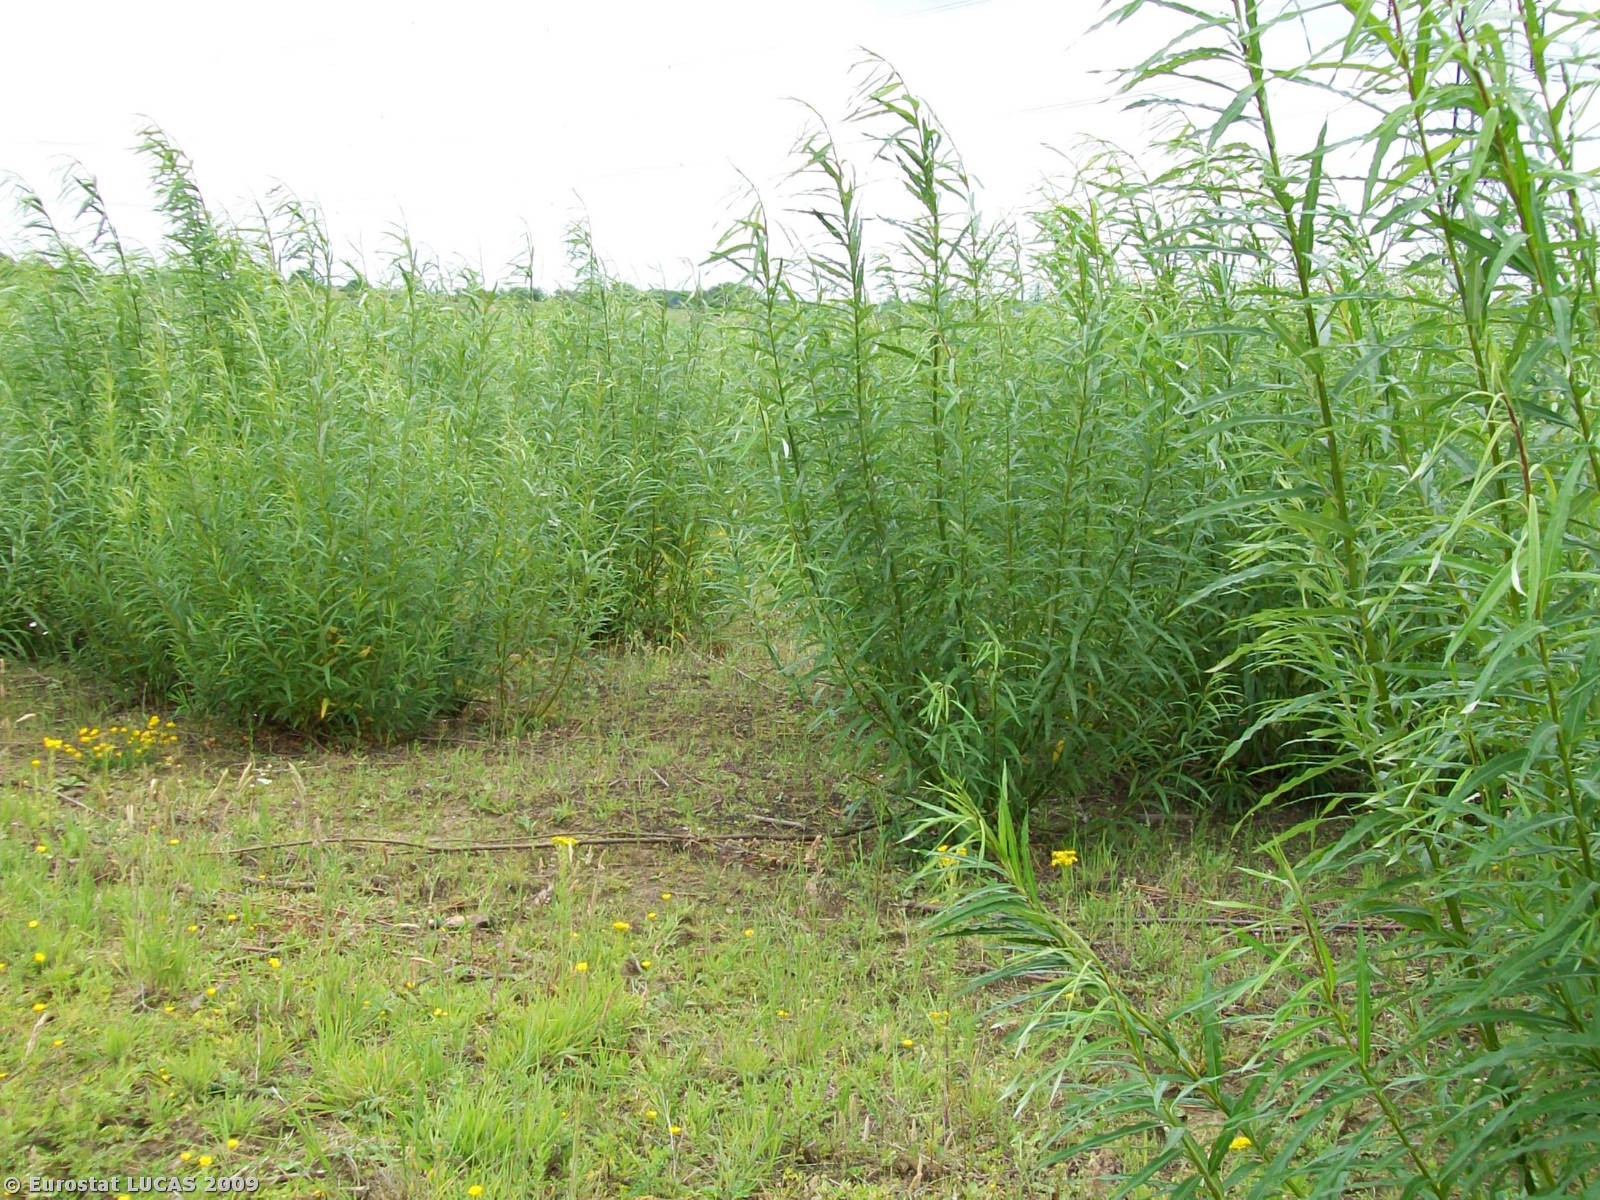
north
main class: Woodland
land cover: Broadleaved woodland
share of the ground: 50 - 75 %
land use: Energy production
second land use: Forestry
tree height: > 5 m
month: July
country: GB
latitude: 53.7361
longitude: -1.3724
